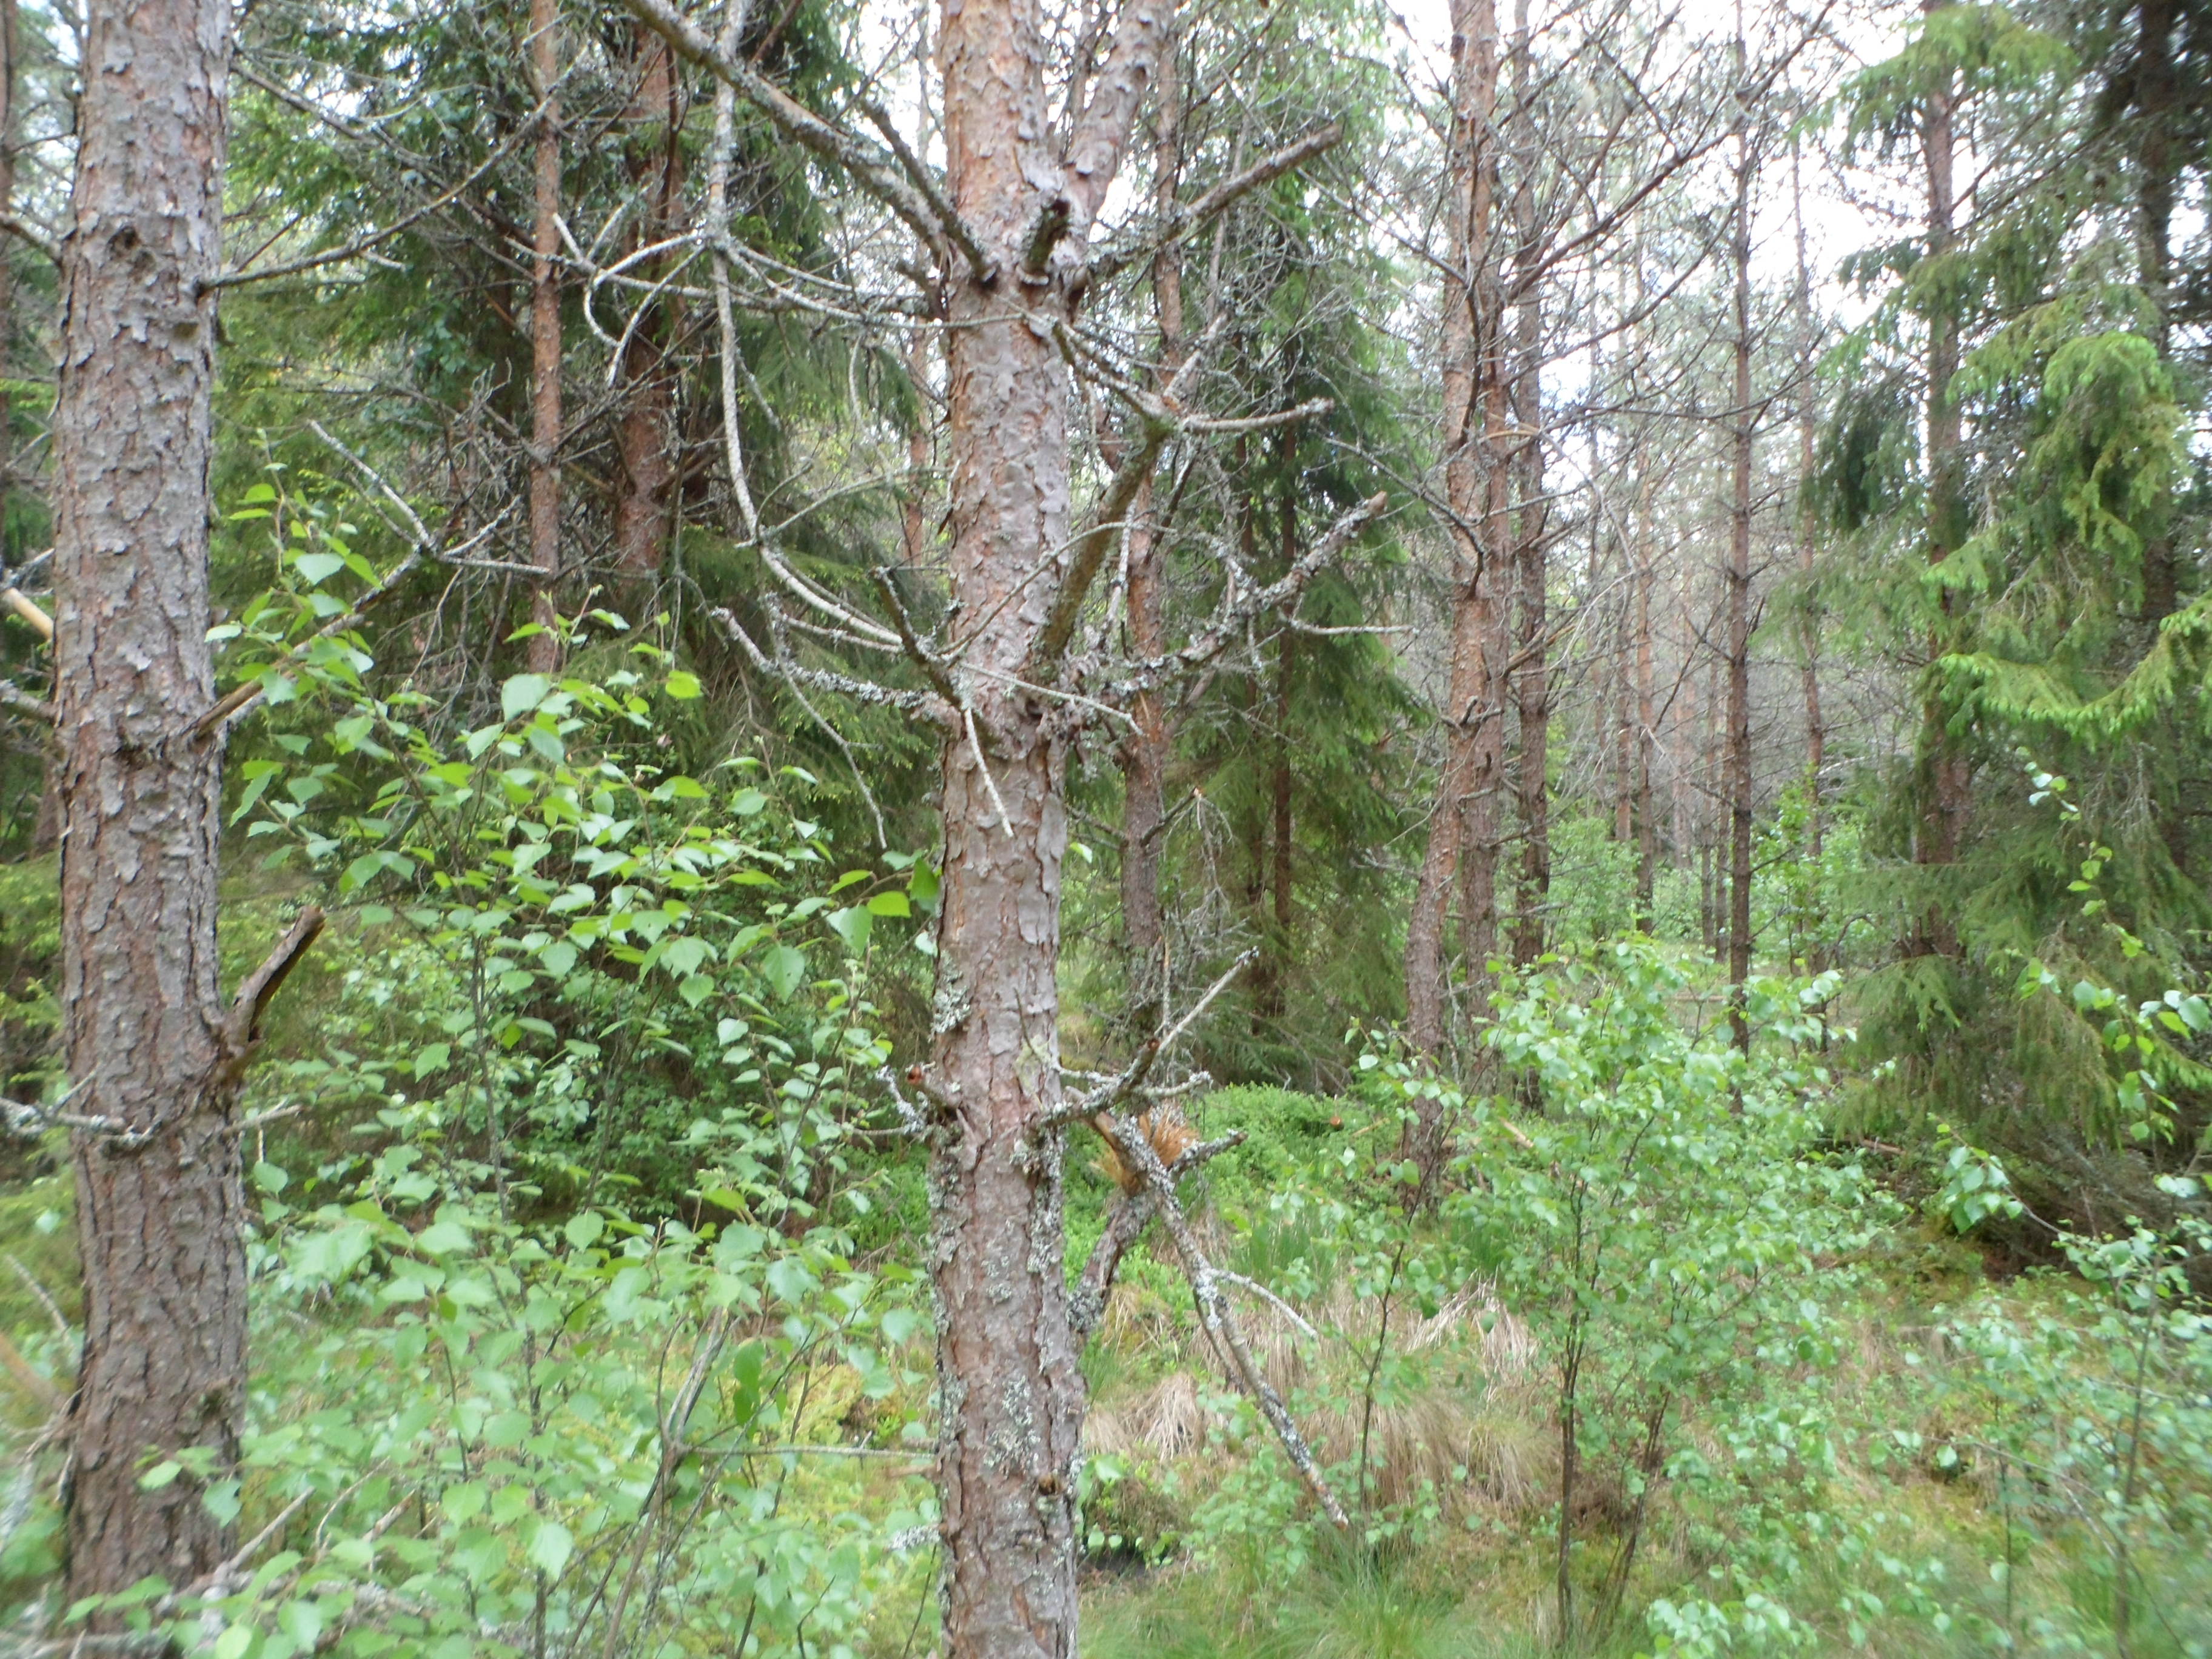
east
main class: Woodland
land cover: Pine dominated coniferous woodland
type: boreal forest
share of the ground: 50 - 75 %
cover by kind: coniferous forest trees 55 %, herbaceous plants 20 %, broadleaved forest trees 10 %, shrubs 10 %, lichens and mosses 5 %
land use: Forestry
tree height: > 5 m
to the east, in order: Pine dominated coniferous woodland; Ditches and canals; Pine dominated coniferous woodland; Ditches and canals; Spruce dominated coniferous woodland; Pine dominated coniferous woodland; Ditches and canals; Pine dominated coniferous woodland; Ditches and canals; Pine dominated coniferous woodland; Grassland with sparse tree/shrub cover; Electric lines; Ditches and canals; Grassland with sparse tree/shrub cover; Pine dominated coniferous woodland
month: June
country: SE
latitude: 56.9738
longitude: 14.4878
